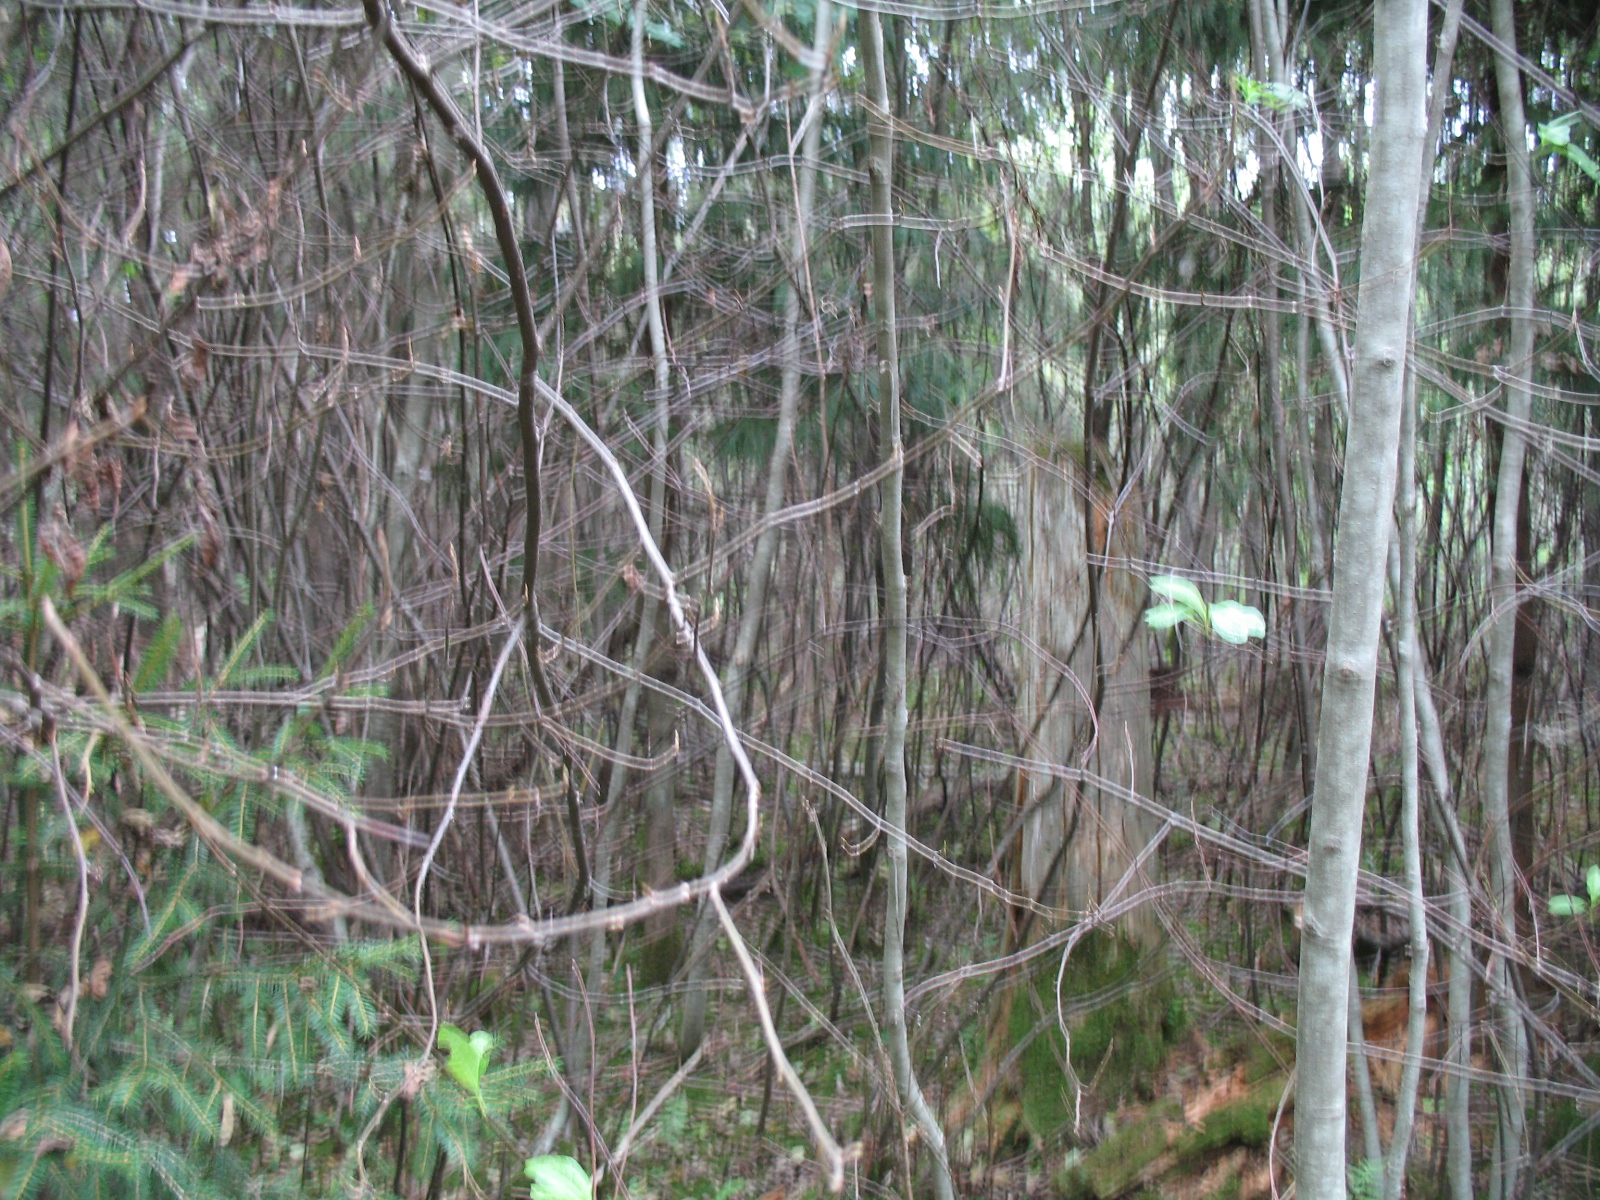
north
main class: Woodland
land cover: Broadleaved woodland
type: non-riverine alder, birch or aspen forest
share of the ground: > 75 %
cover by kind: broadleaved forest trees 80 %, coniferous forest trees 10 %, herbaceous plants 5 %, lichens and mosses 5 %
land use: Forestry
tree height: > 5 m
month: August
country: LV
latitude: 56.2779
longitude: 25.5465
